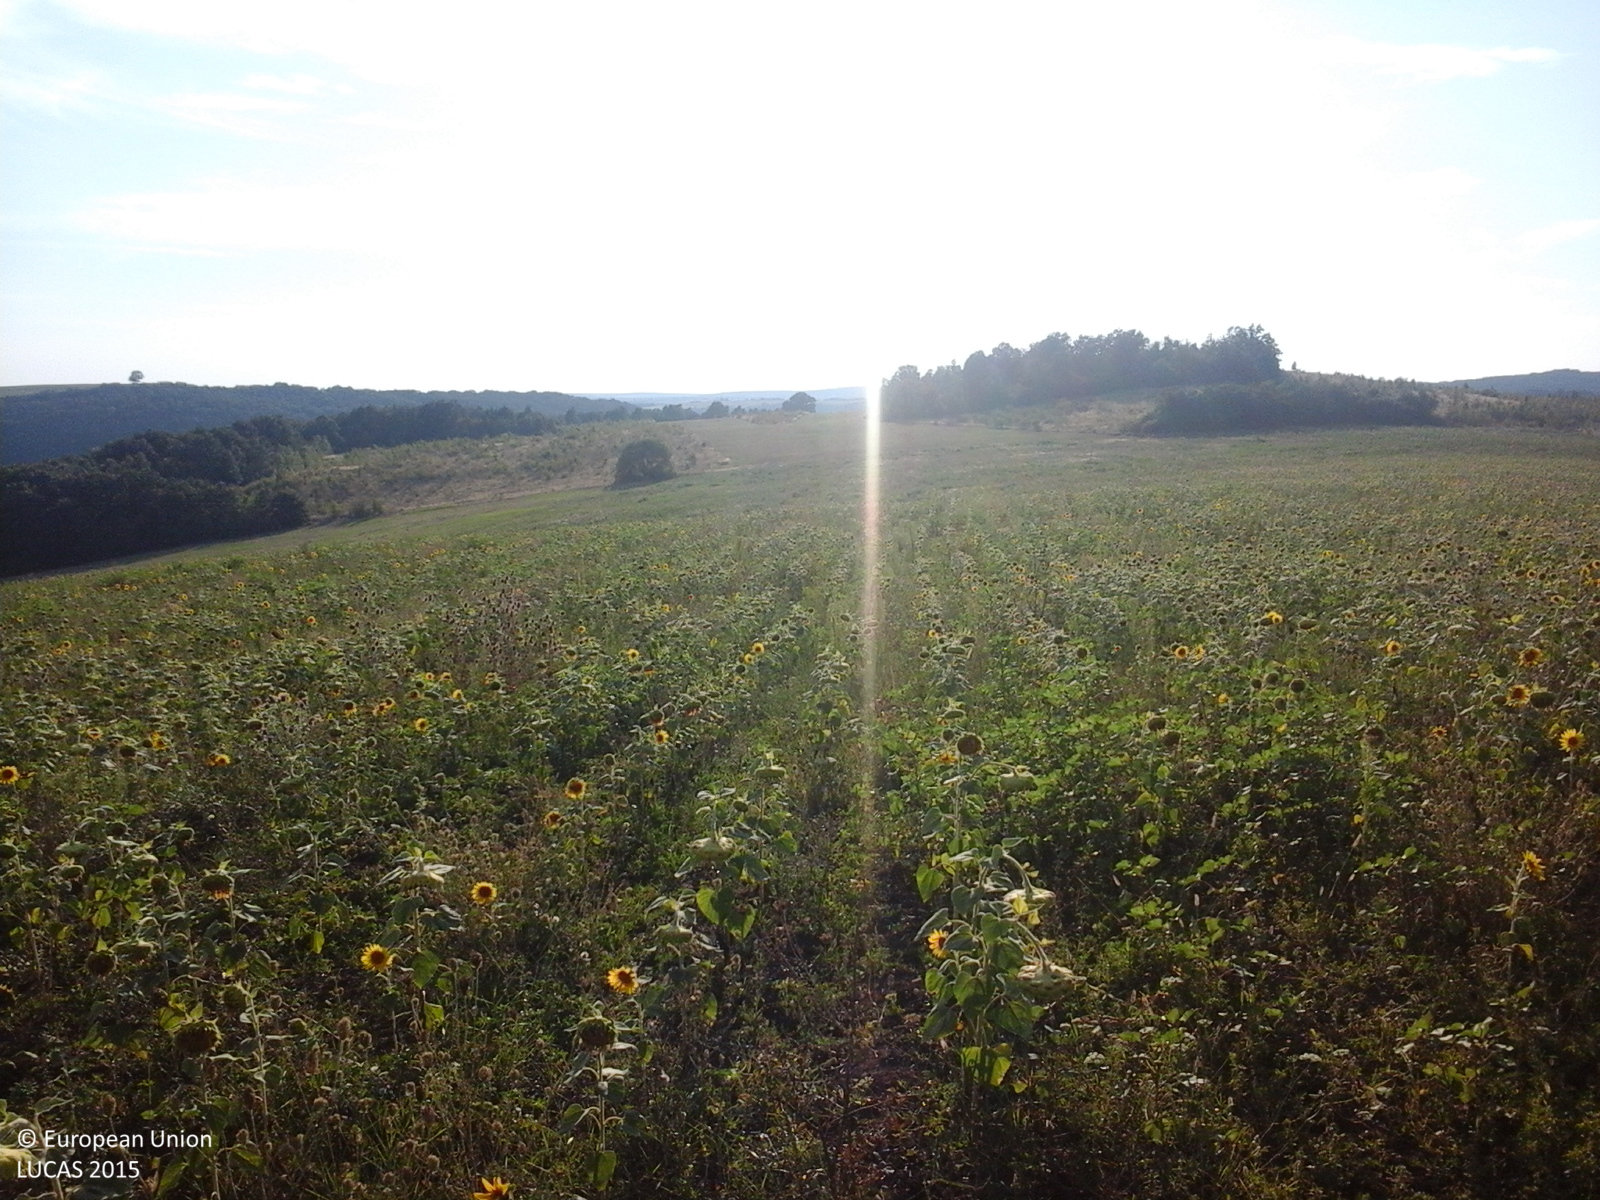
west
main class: Cropland
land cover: Sunflower
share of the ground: 50 - 75 %
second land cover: Spontaneously vegetated surfaces
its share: 10 - 25 %
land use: Agriculture (excluding fallow land and kitchen gardens)
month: August
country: RO
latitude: 45.9177
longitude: 21.6012
